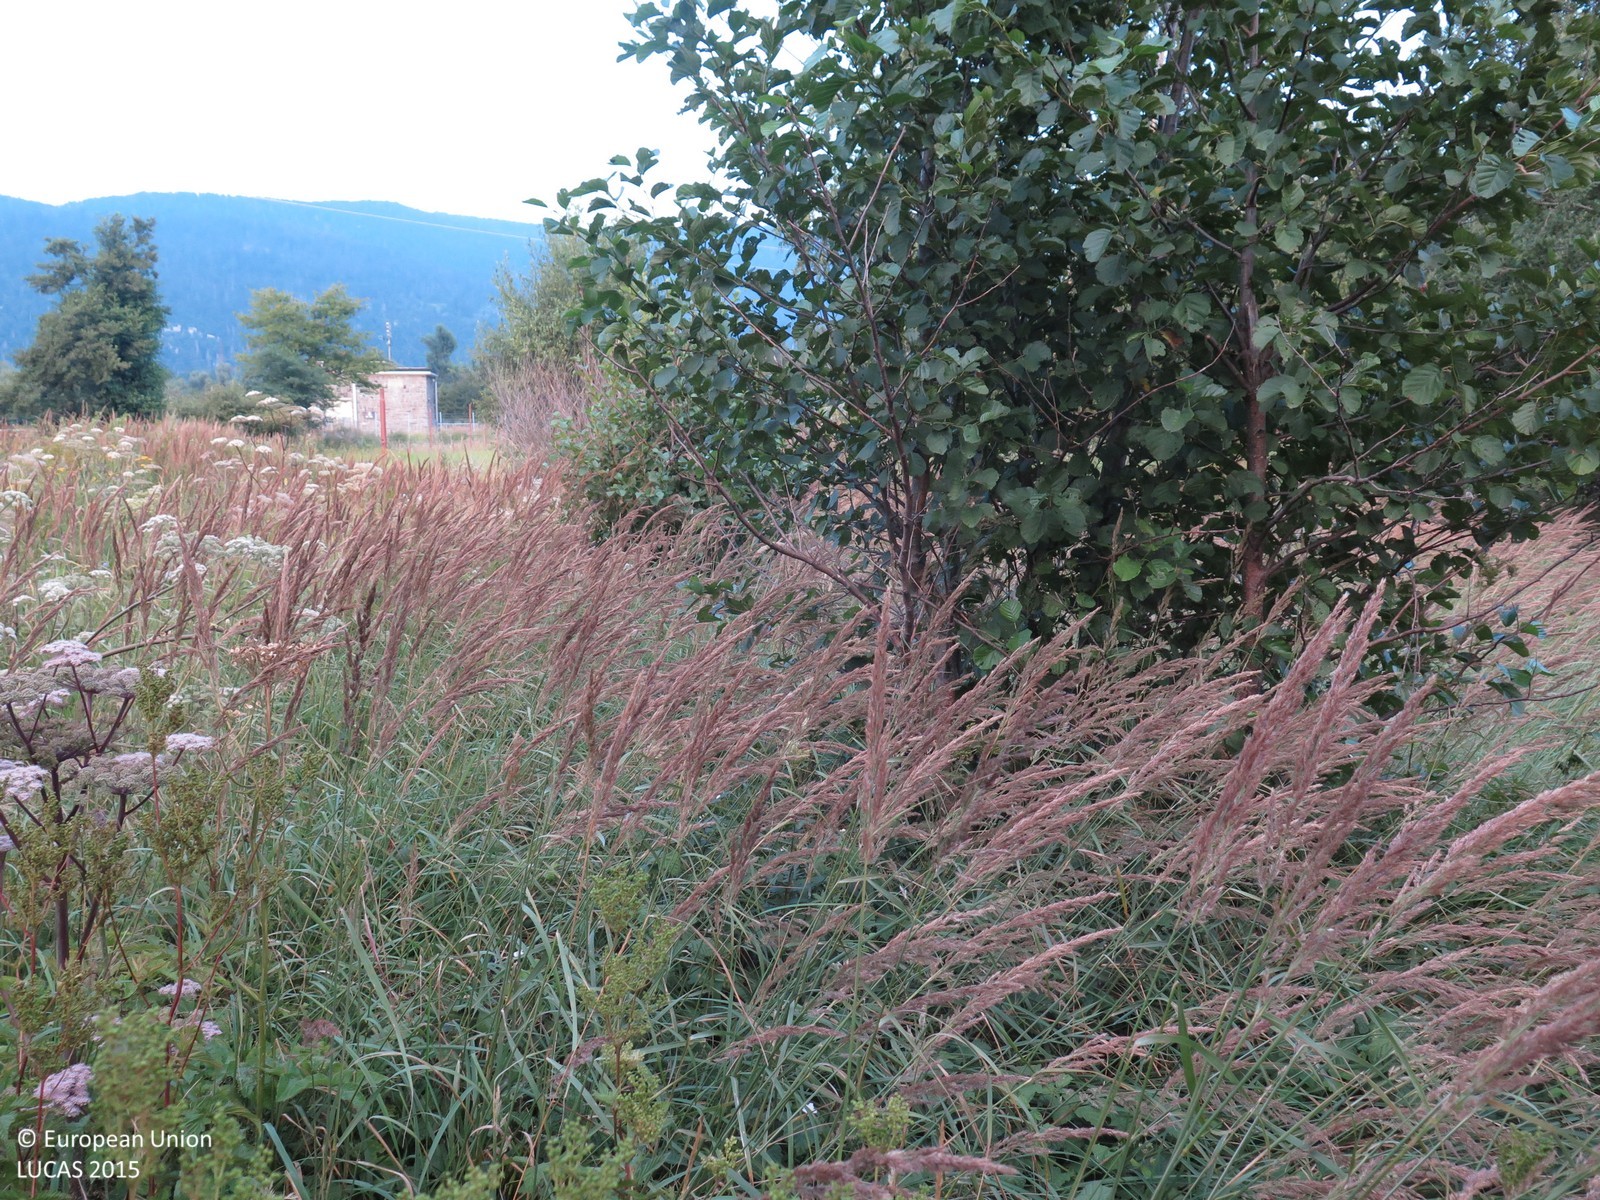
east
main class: Shrubland
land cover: Shrubland with sparse tree cover
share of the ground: > 75 %
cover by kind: shrubs 90 %, broadleaved forest trees 5 %, herbaceous plants 5 %
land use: Semi-natural and natural areas not in use
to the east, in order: Shrubland with sparse tree cover; Grassland with sparse tree/shrub cover; Abandoned hedges; Electric lines; Grassland without tree/shrub cover; Fences; Other fruit trees and berries; Fences; Tracks; Broadleaved woodland; Grassland without tree/shrub cover; Electric lines; Tracks; Fences; Inland fresh water bodies; Lines of trees; Grassland without tree/shrub cover; Broadleaved woodland; Grassland without tree/shrub cover; Broadleaved woodland
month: August
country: HR
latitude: 45.2903
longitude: 14.7254
